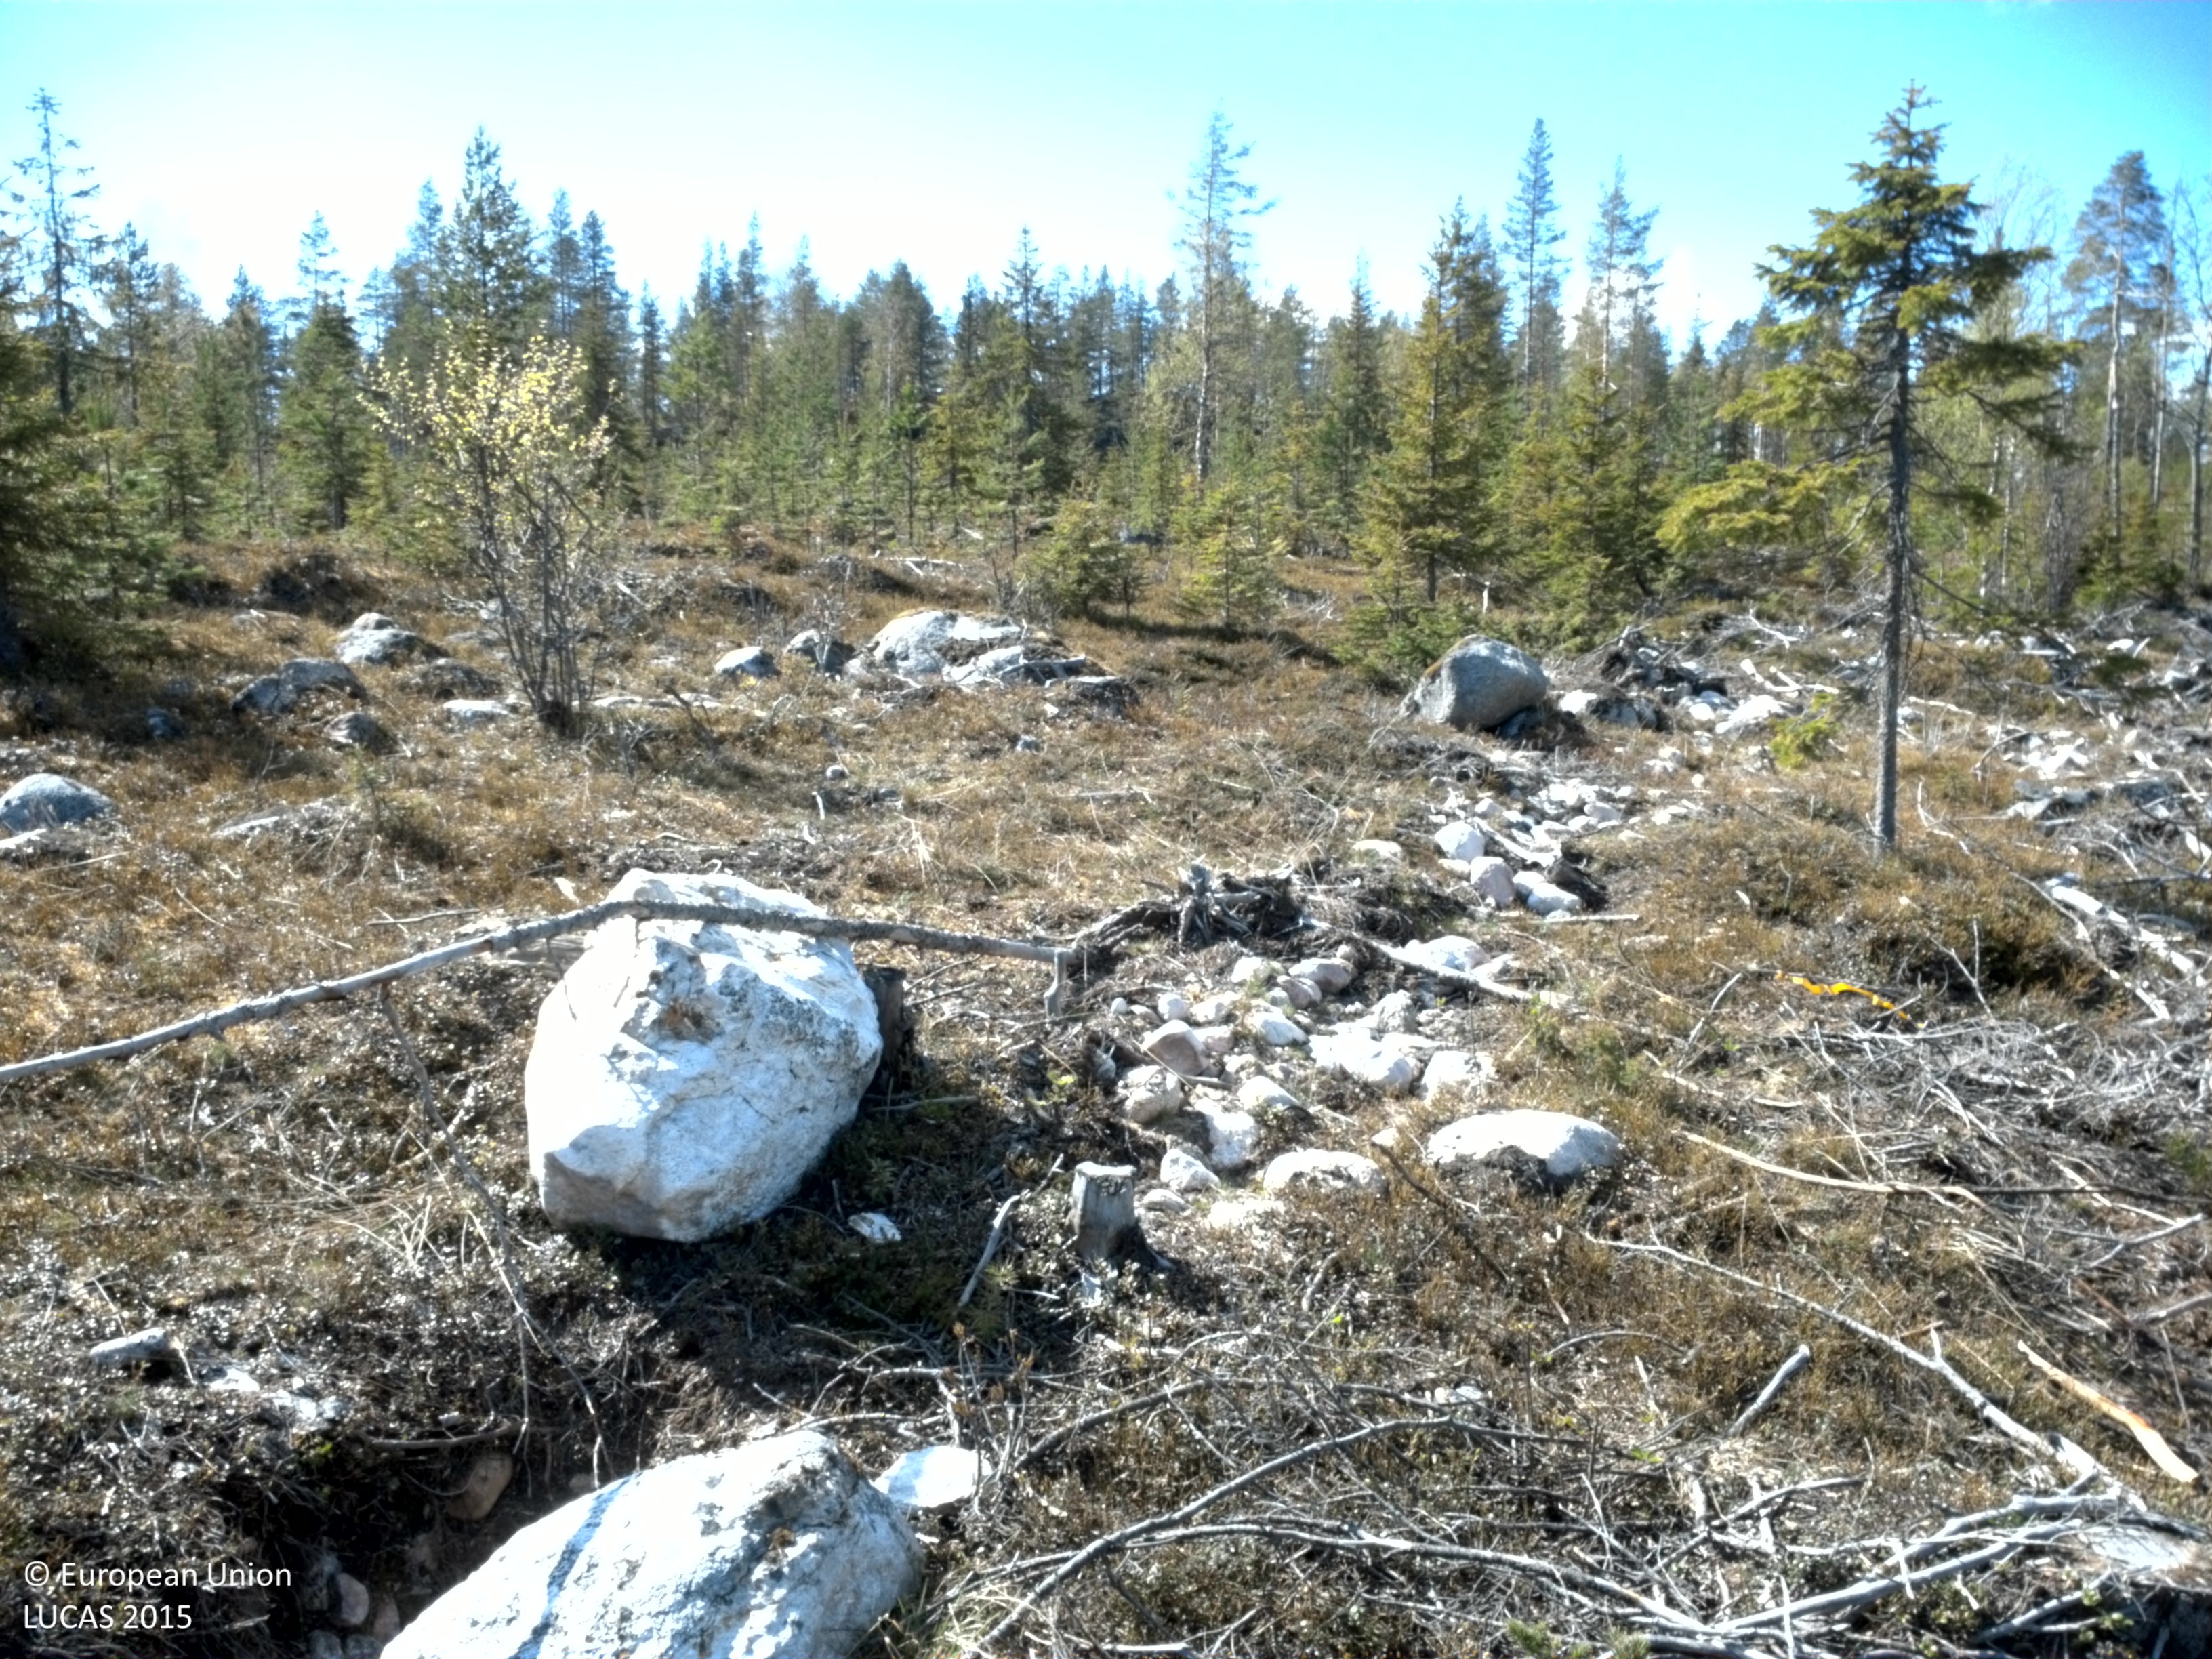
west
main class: Shrubland
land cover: Shrubland with sparse tree cover
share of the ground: > 75 %
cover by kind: shrubs 85 %, unconsolidated bare surface 10 %, coniferous forest trees 5 %
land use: Forestry
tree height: < 5 m
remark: Clear cut
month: May
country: SE
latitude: 66.1267
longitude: 23.1597
